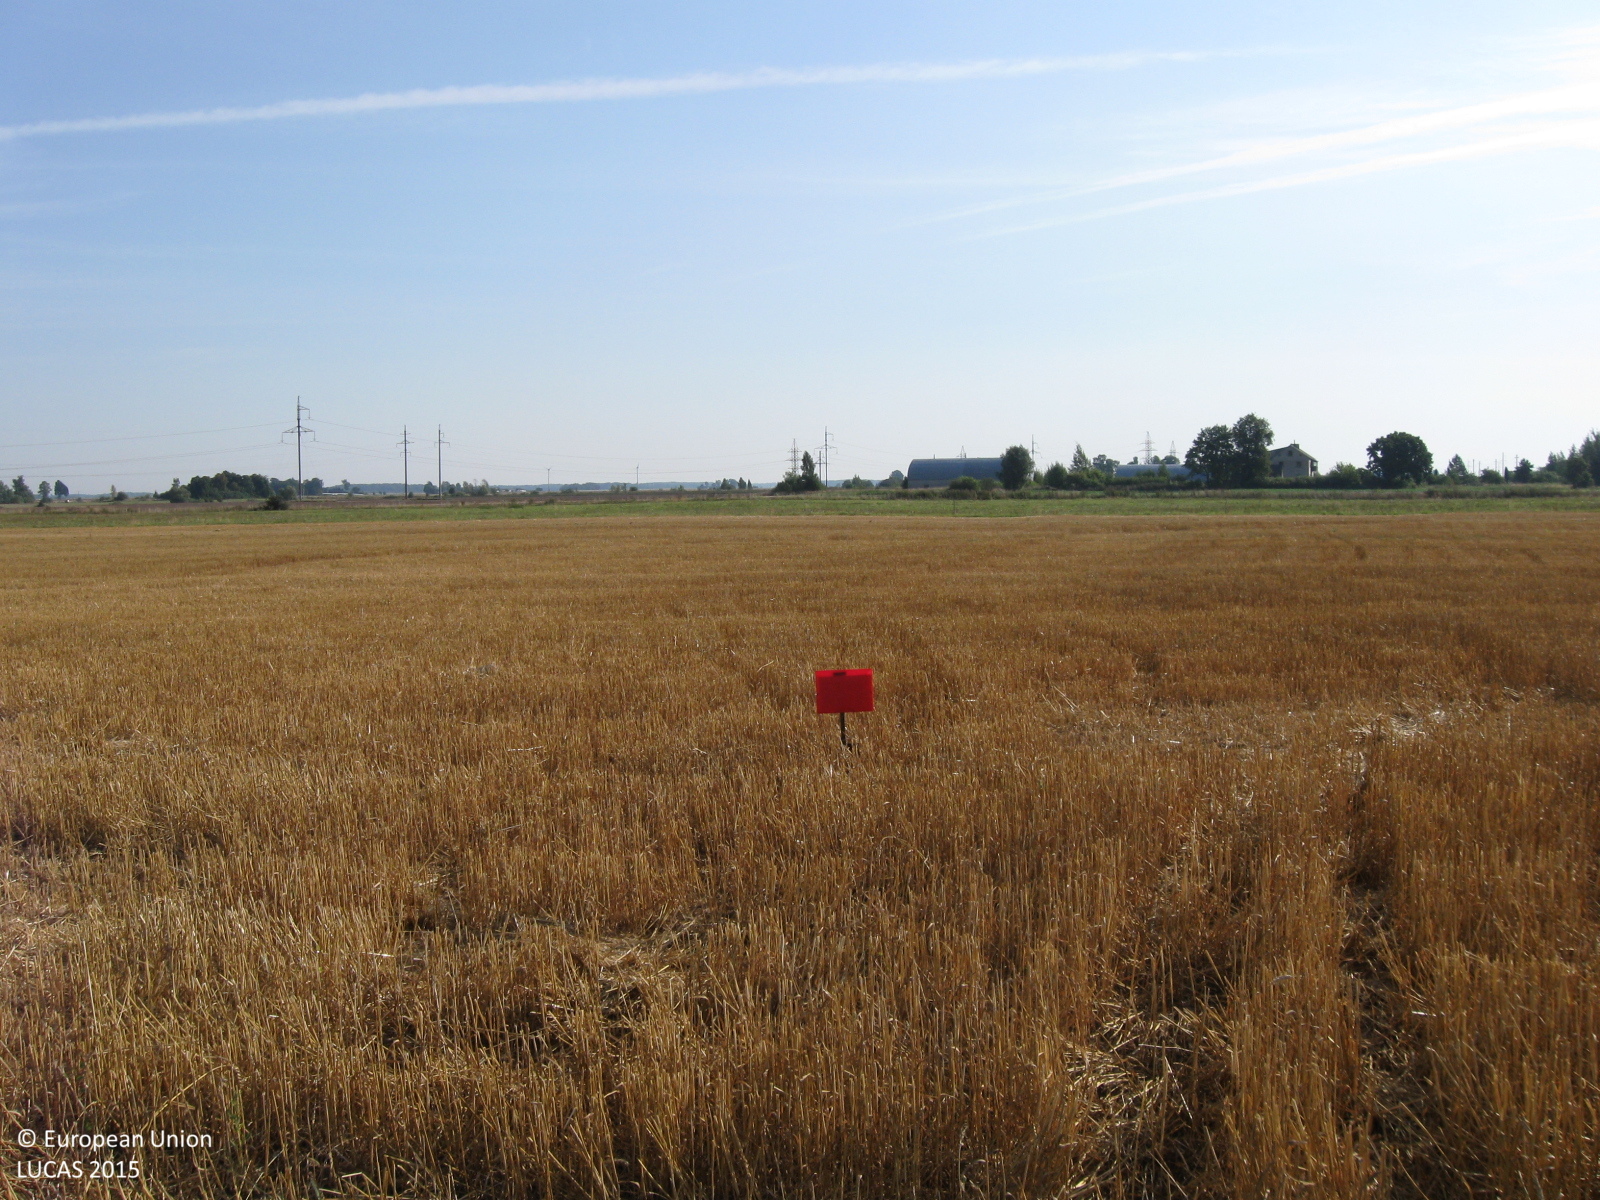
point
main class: Cropland
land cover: Common wheat
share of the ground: > 75 %
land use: Agriculture (excluding fallow land and kitchen gardens)
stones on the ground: < 10 %
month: August
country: LT
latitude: 55.1016
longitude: 22.8413
